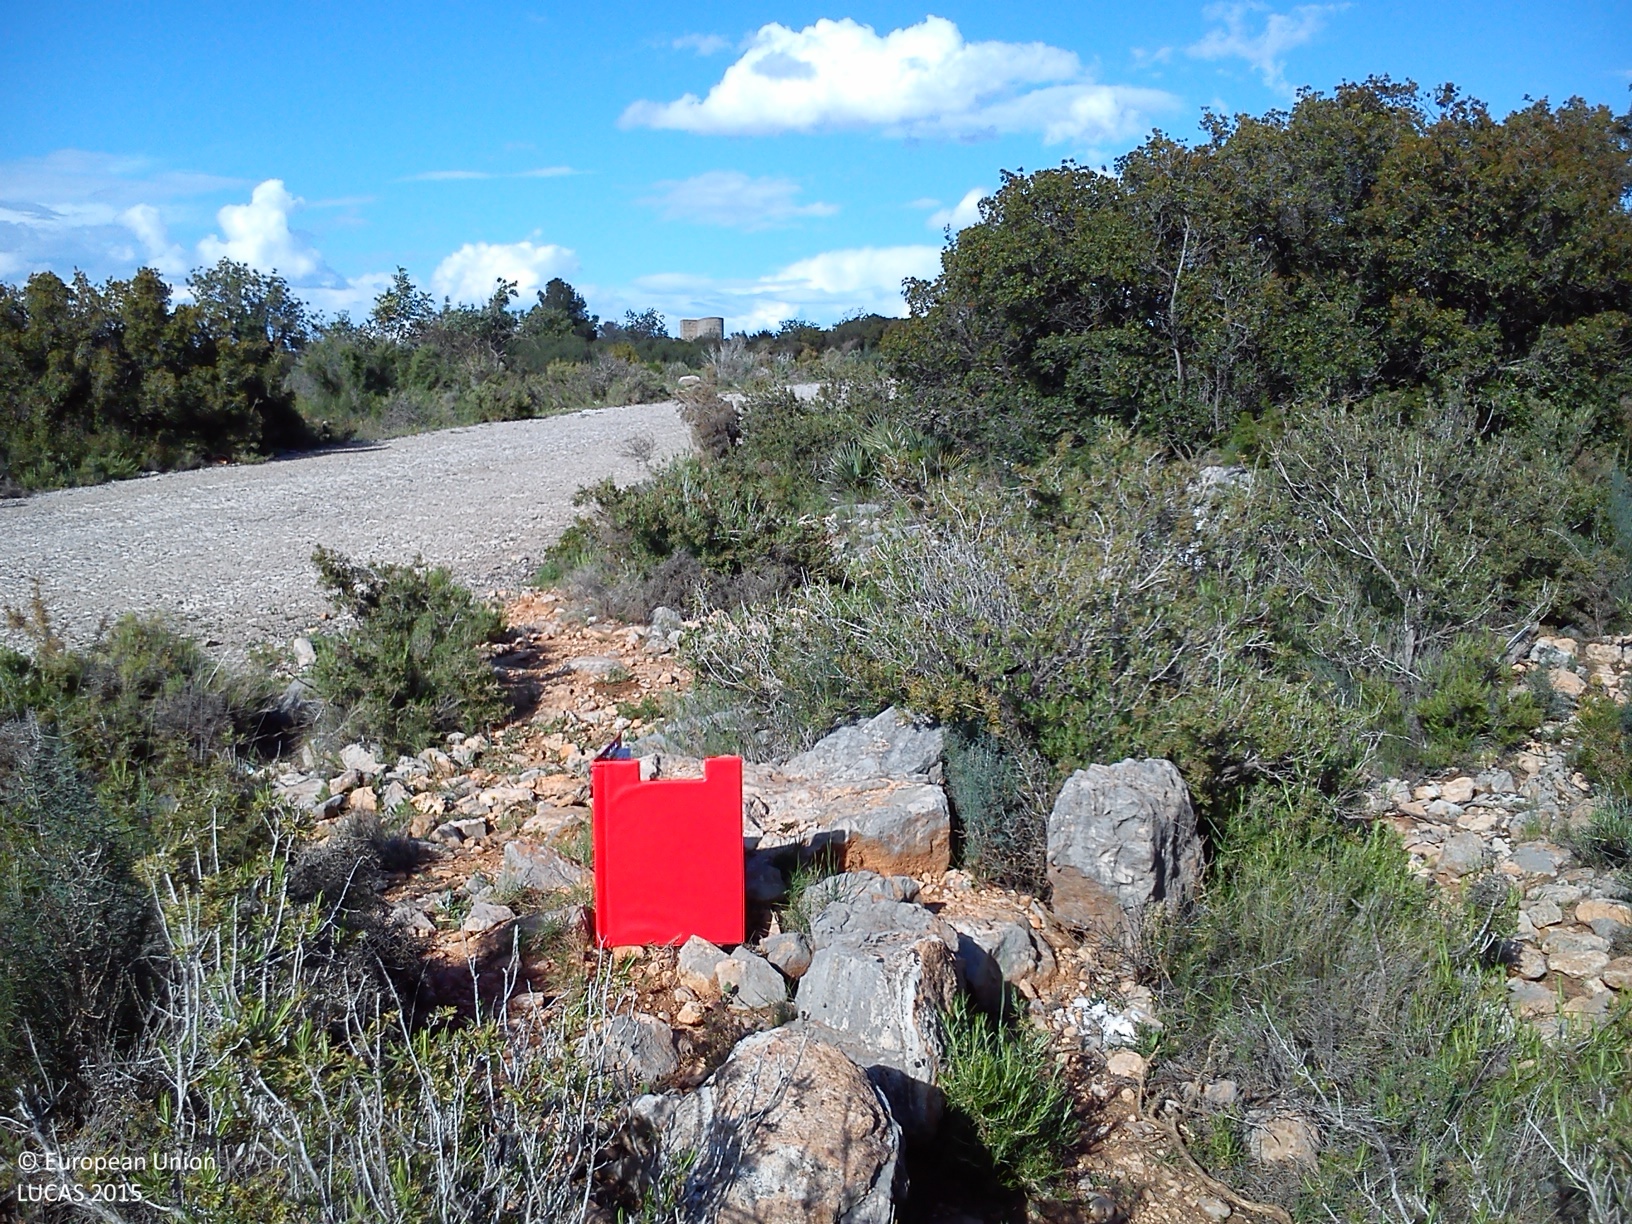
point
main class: Shrubland
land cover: Shrubland with sparse tree cover
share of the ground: > 75 %
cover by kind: shrubs 90 %, coniferous forest trees 5 %, consolidated bare surface 5 %
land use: Semi-natural and natural areas not in use
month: April
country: ES
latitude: 39.4842
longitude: -0.6601
